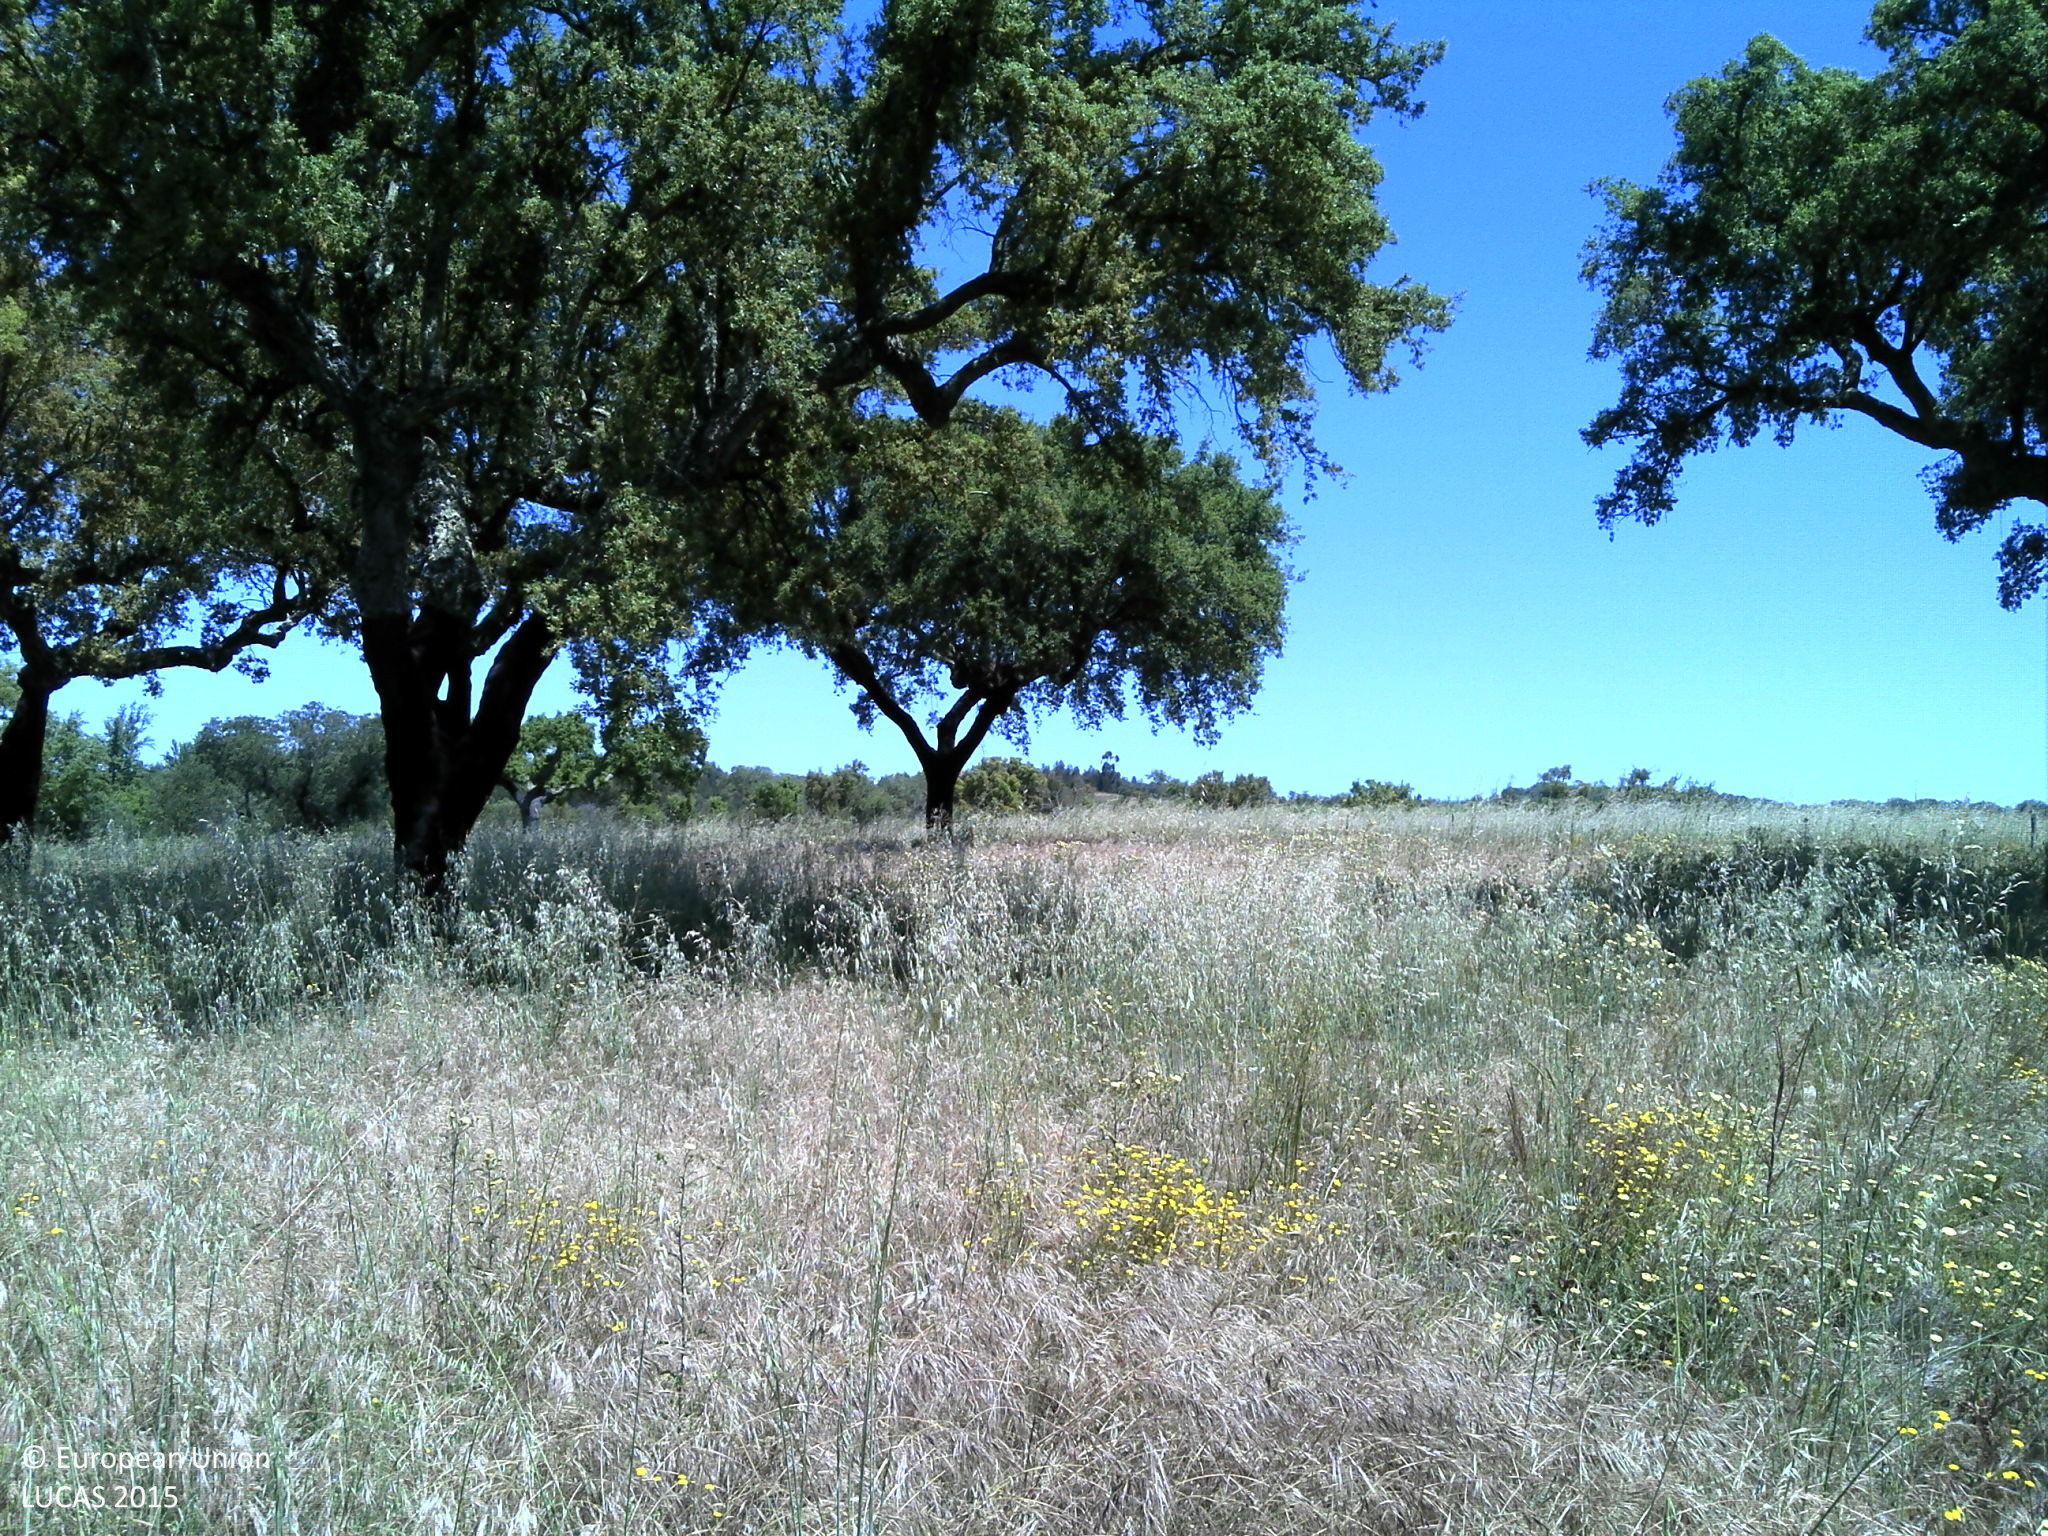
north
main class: Grassland
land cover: Grassland with sparse tree/shrub cover
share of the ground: > 75 %
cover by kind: herbaceous plants 90 %, broadleaved forest trees 5 %, unconsolidated bare surface 5 %
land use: Agriculture (excluding fallow land and kitchen gardens)
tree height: > 5 m
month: May
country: PT
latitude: 39.2026
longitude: -7.8718
